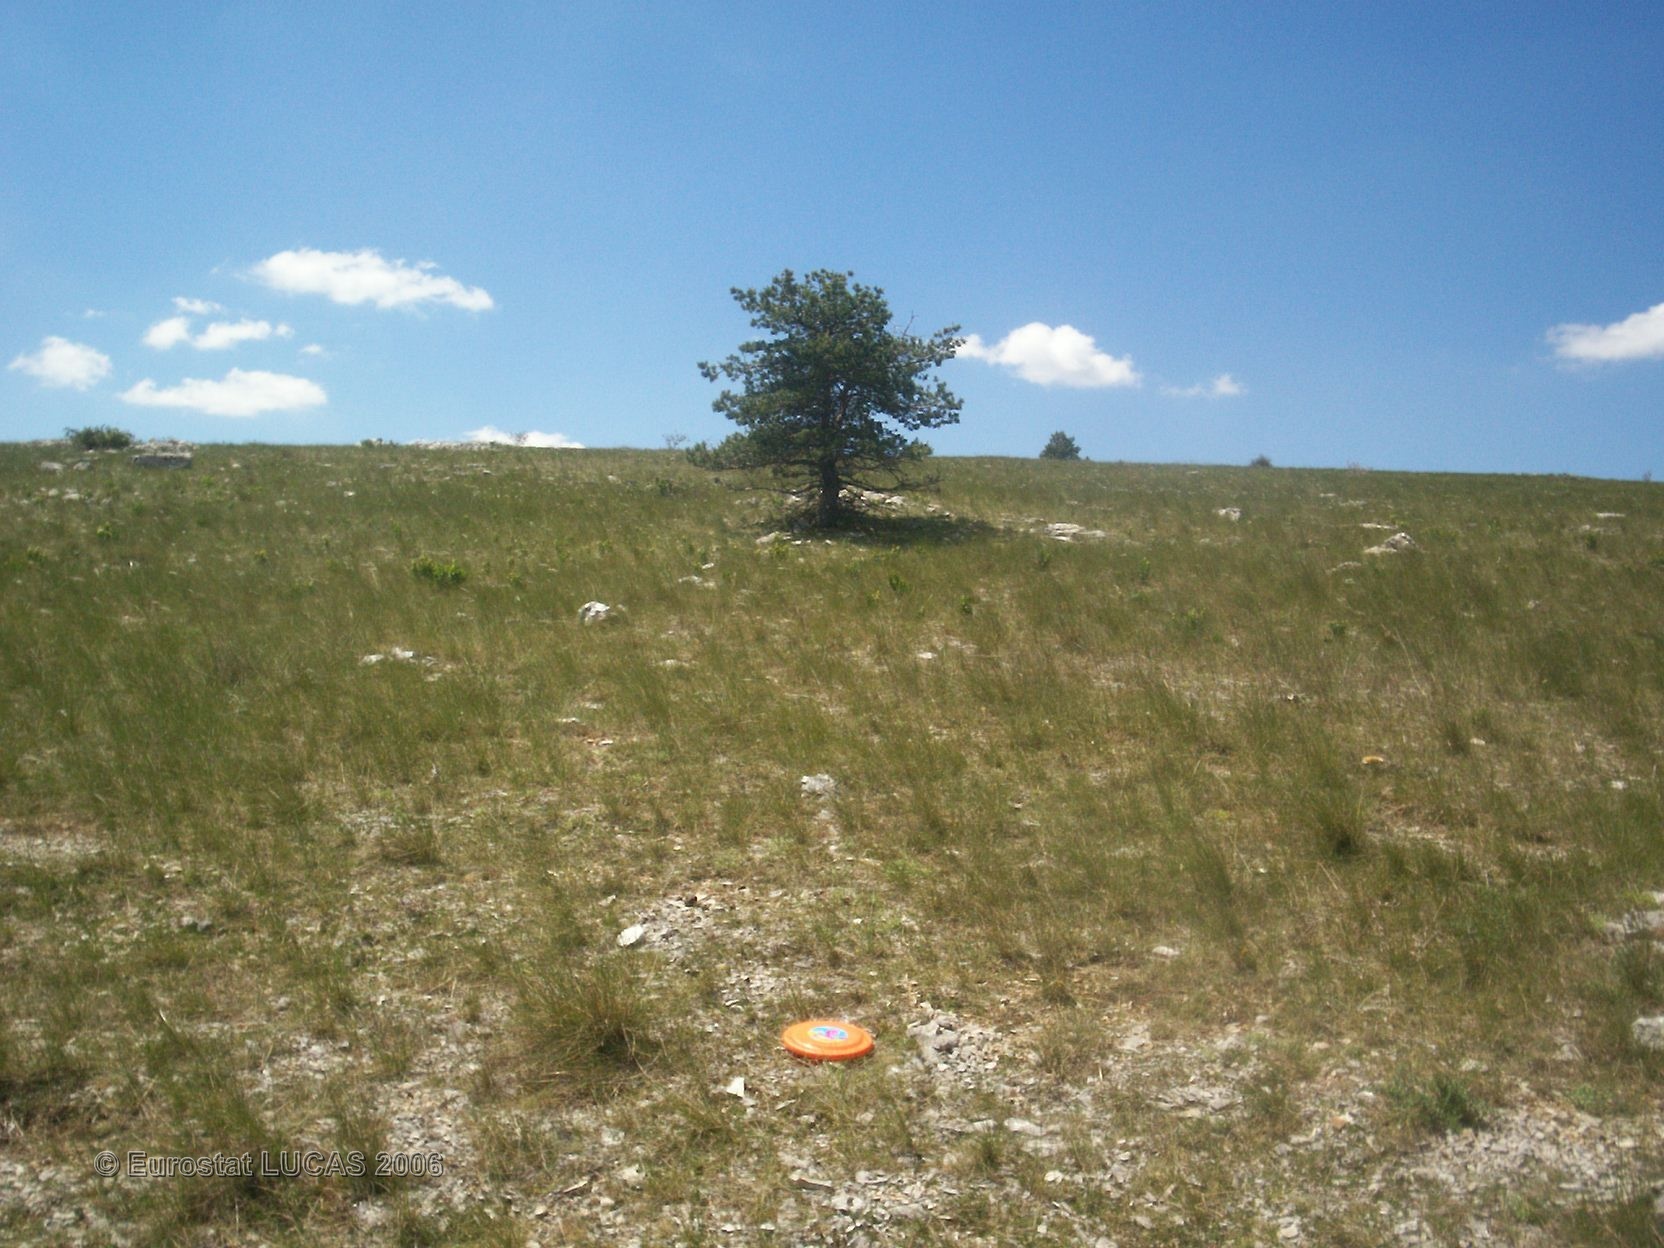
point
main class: Grassland
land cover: Grassland without tree/shrub cover
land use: Agriculture (excluding fallow land and kitchen gardens)
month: June
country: FR
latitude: 44.2134
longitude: 3.4103
